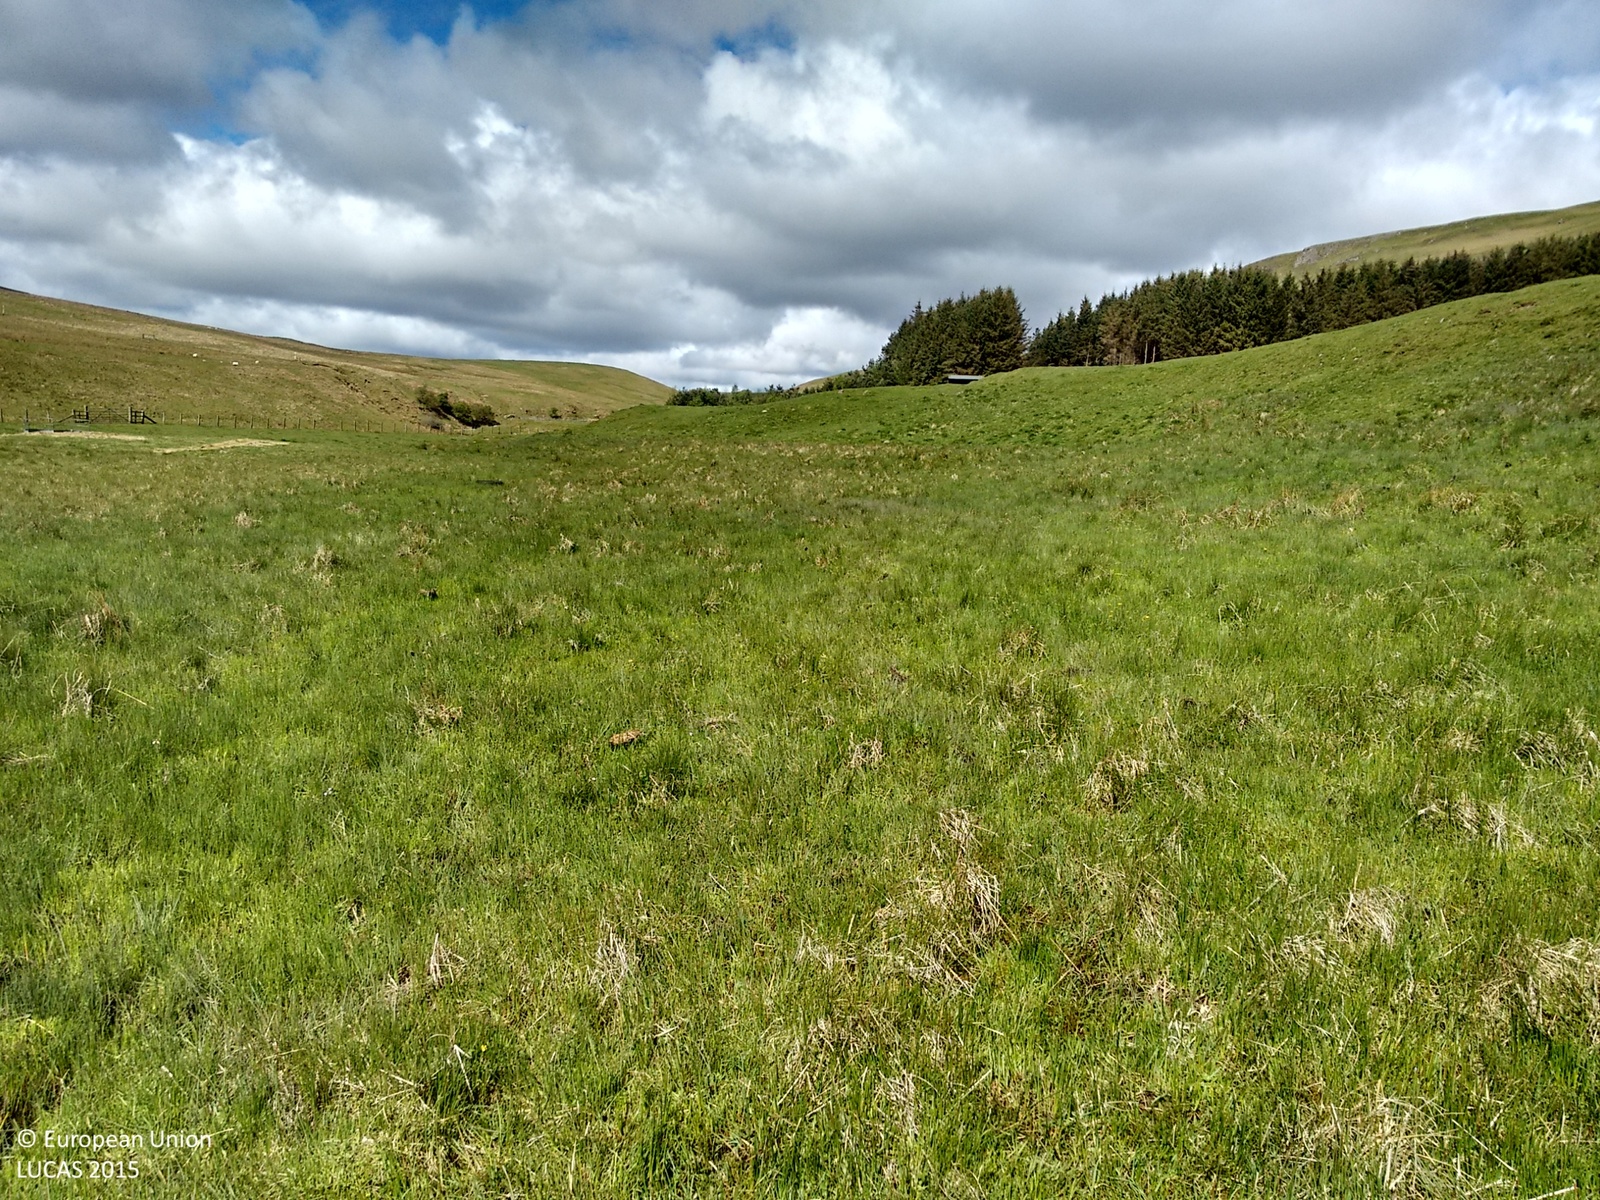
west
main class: Grassland
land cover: Grassland without tree/shrub cover
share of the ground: > 75 %
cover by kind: herbaceous plants 100 %
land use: Agriculture (excluding fallow land and kitchen gardens)
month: May
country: GB
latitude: 55.3497
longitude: -2.1840
